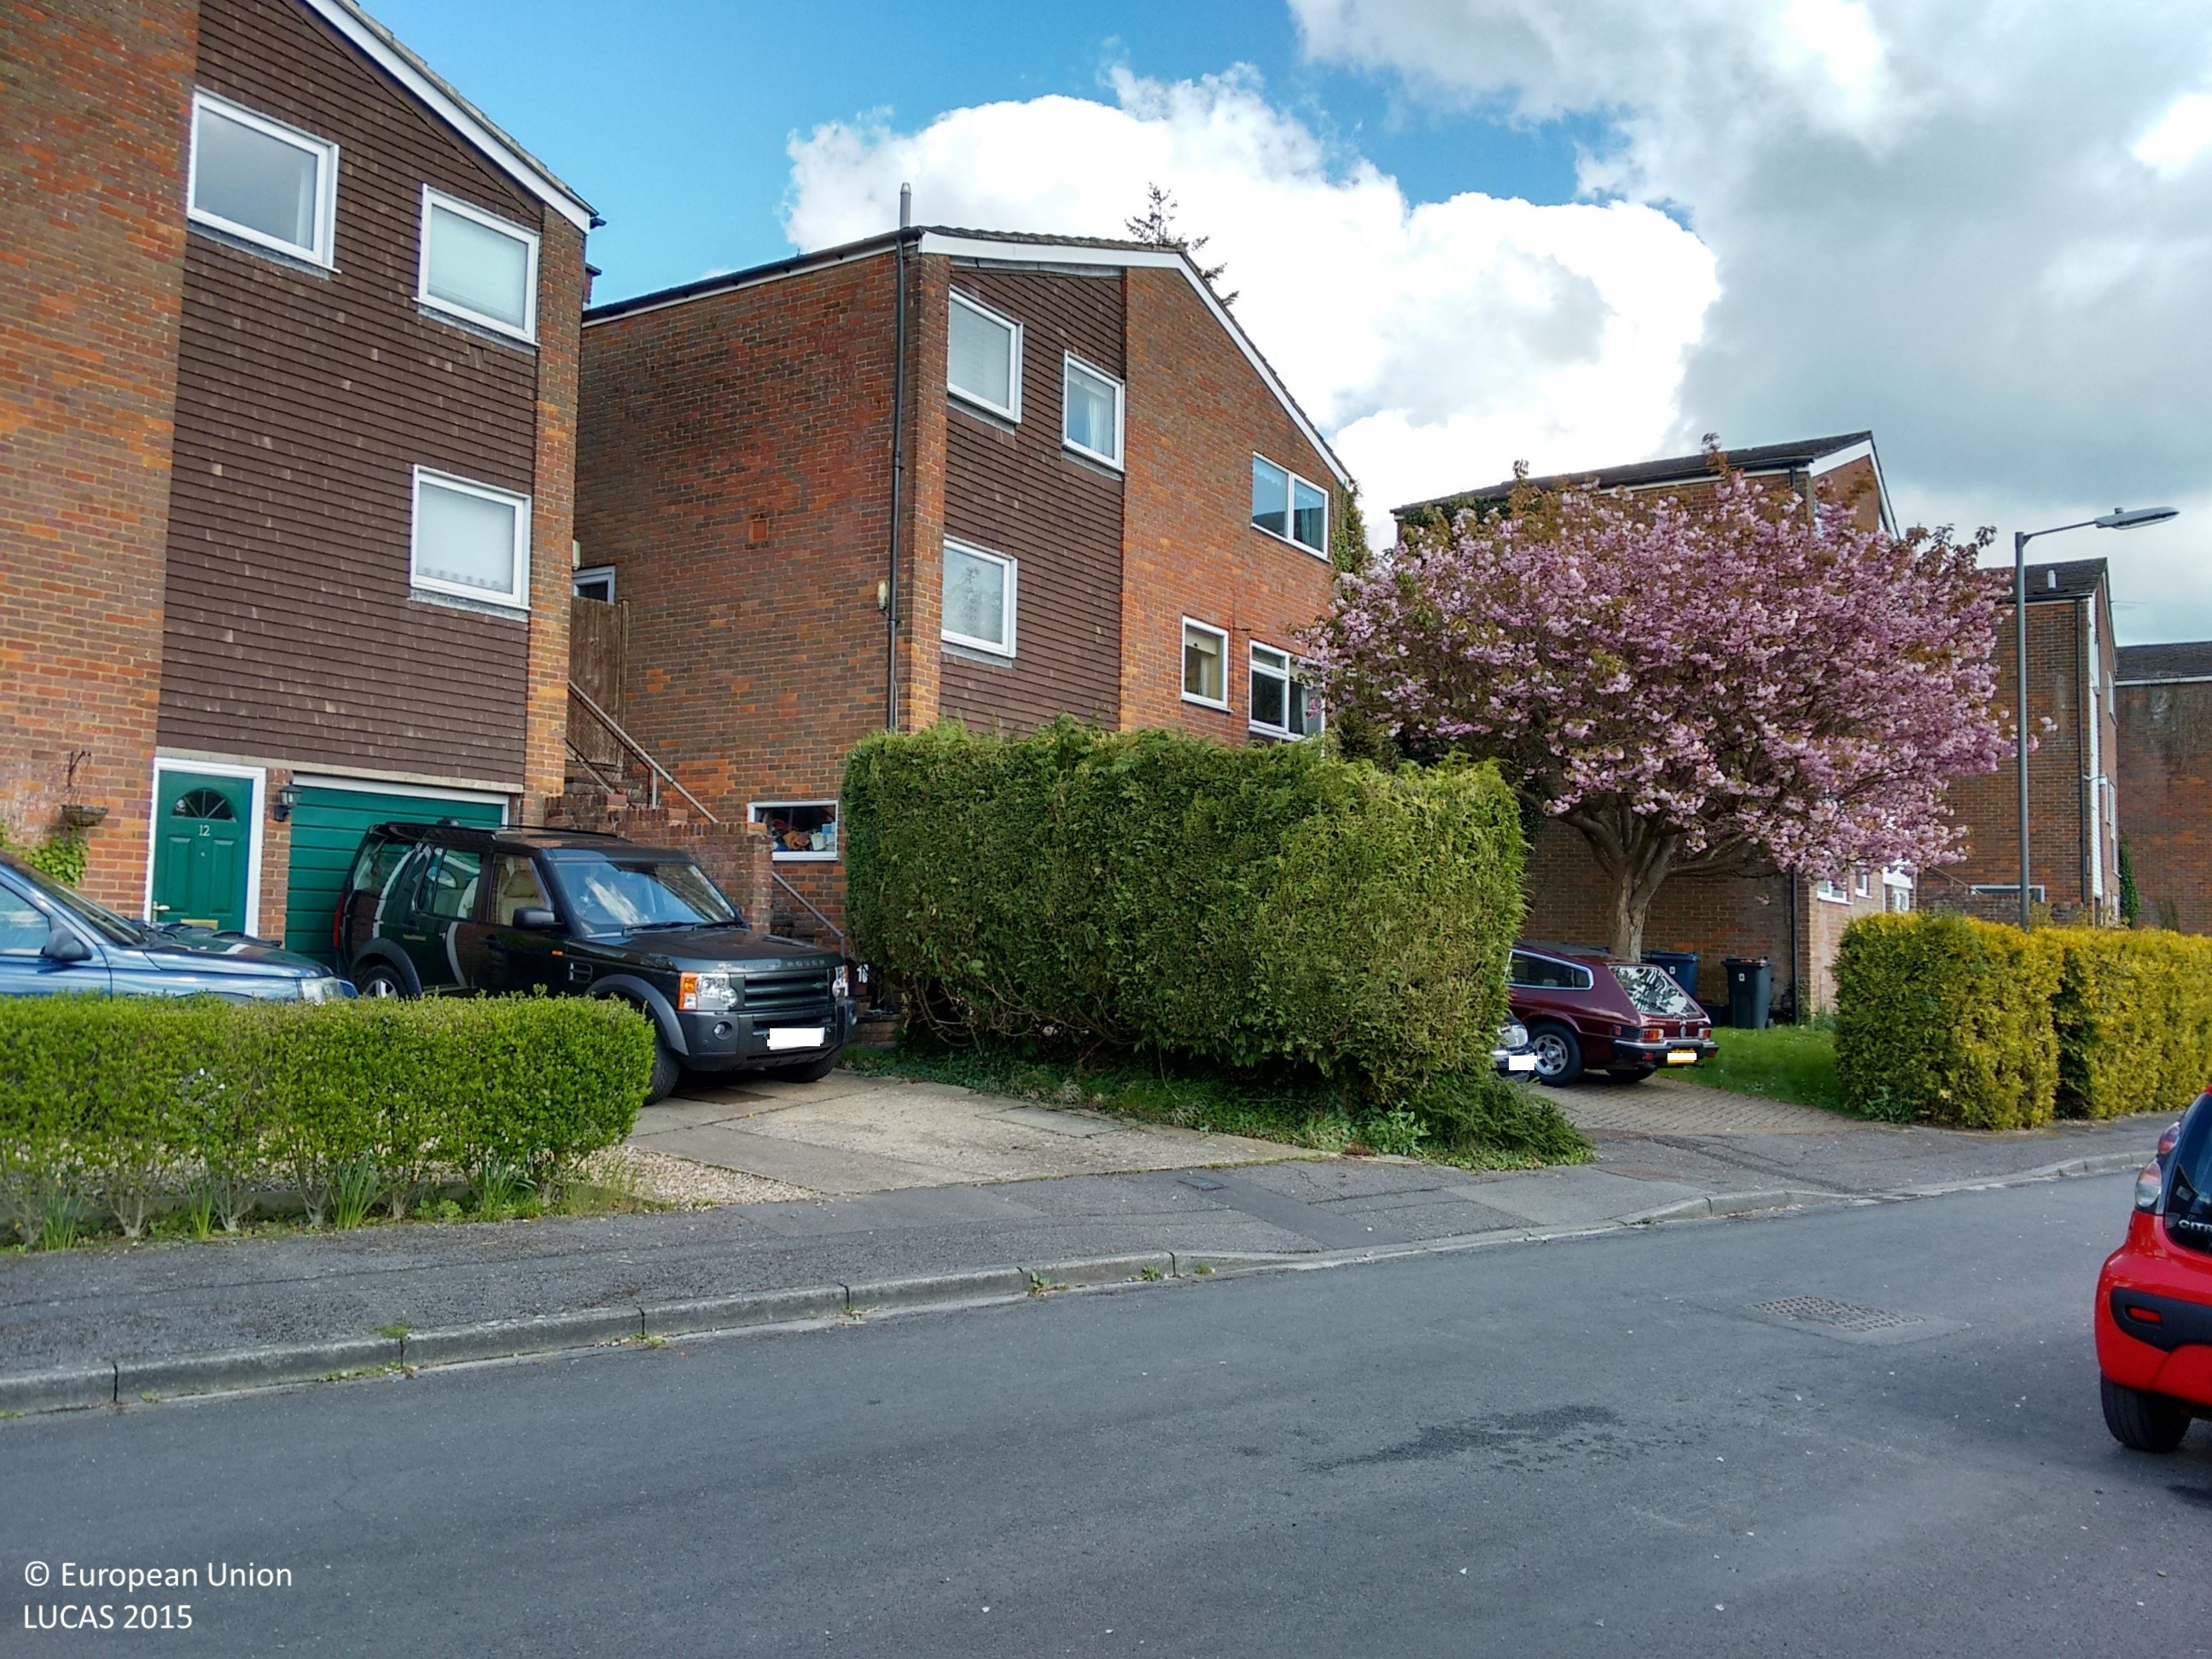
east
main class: Woodland
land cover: Broadleaved woodland
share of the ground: > 75 %
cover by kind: broadleaved forest trees 50 %, herbaceous plants 50 %
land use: Residential
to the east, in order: Broadleaved woodland; Artificial constructions in urban areas
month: April
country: GB
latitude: 51.7182
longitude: -0.6209
